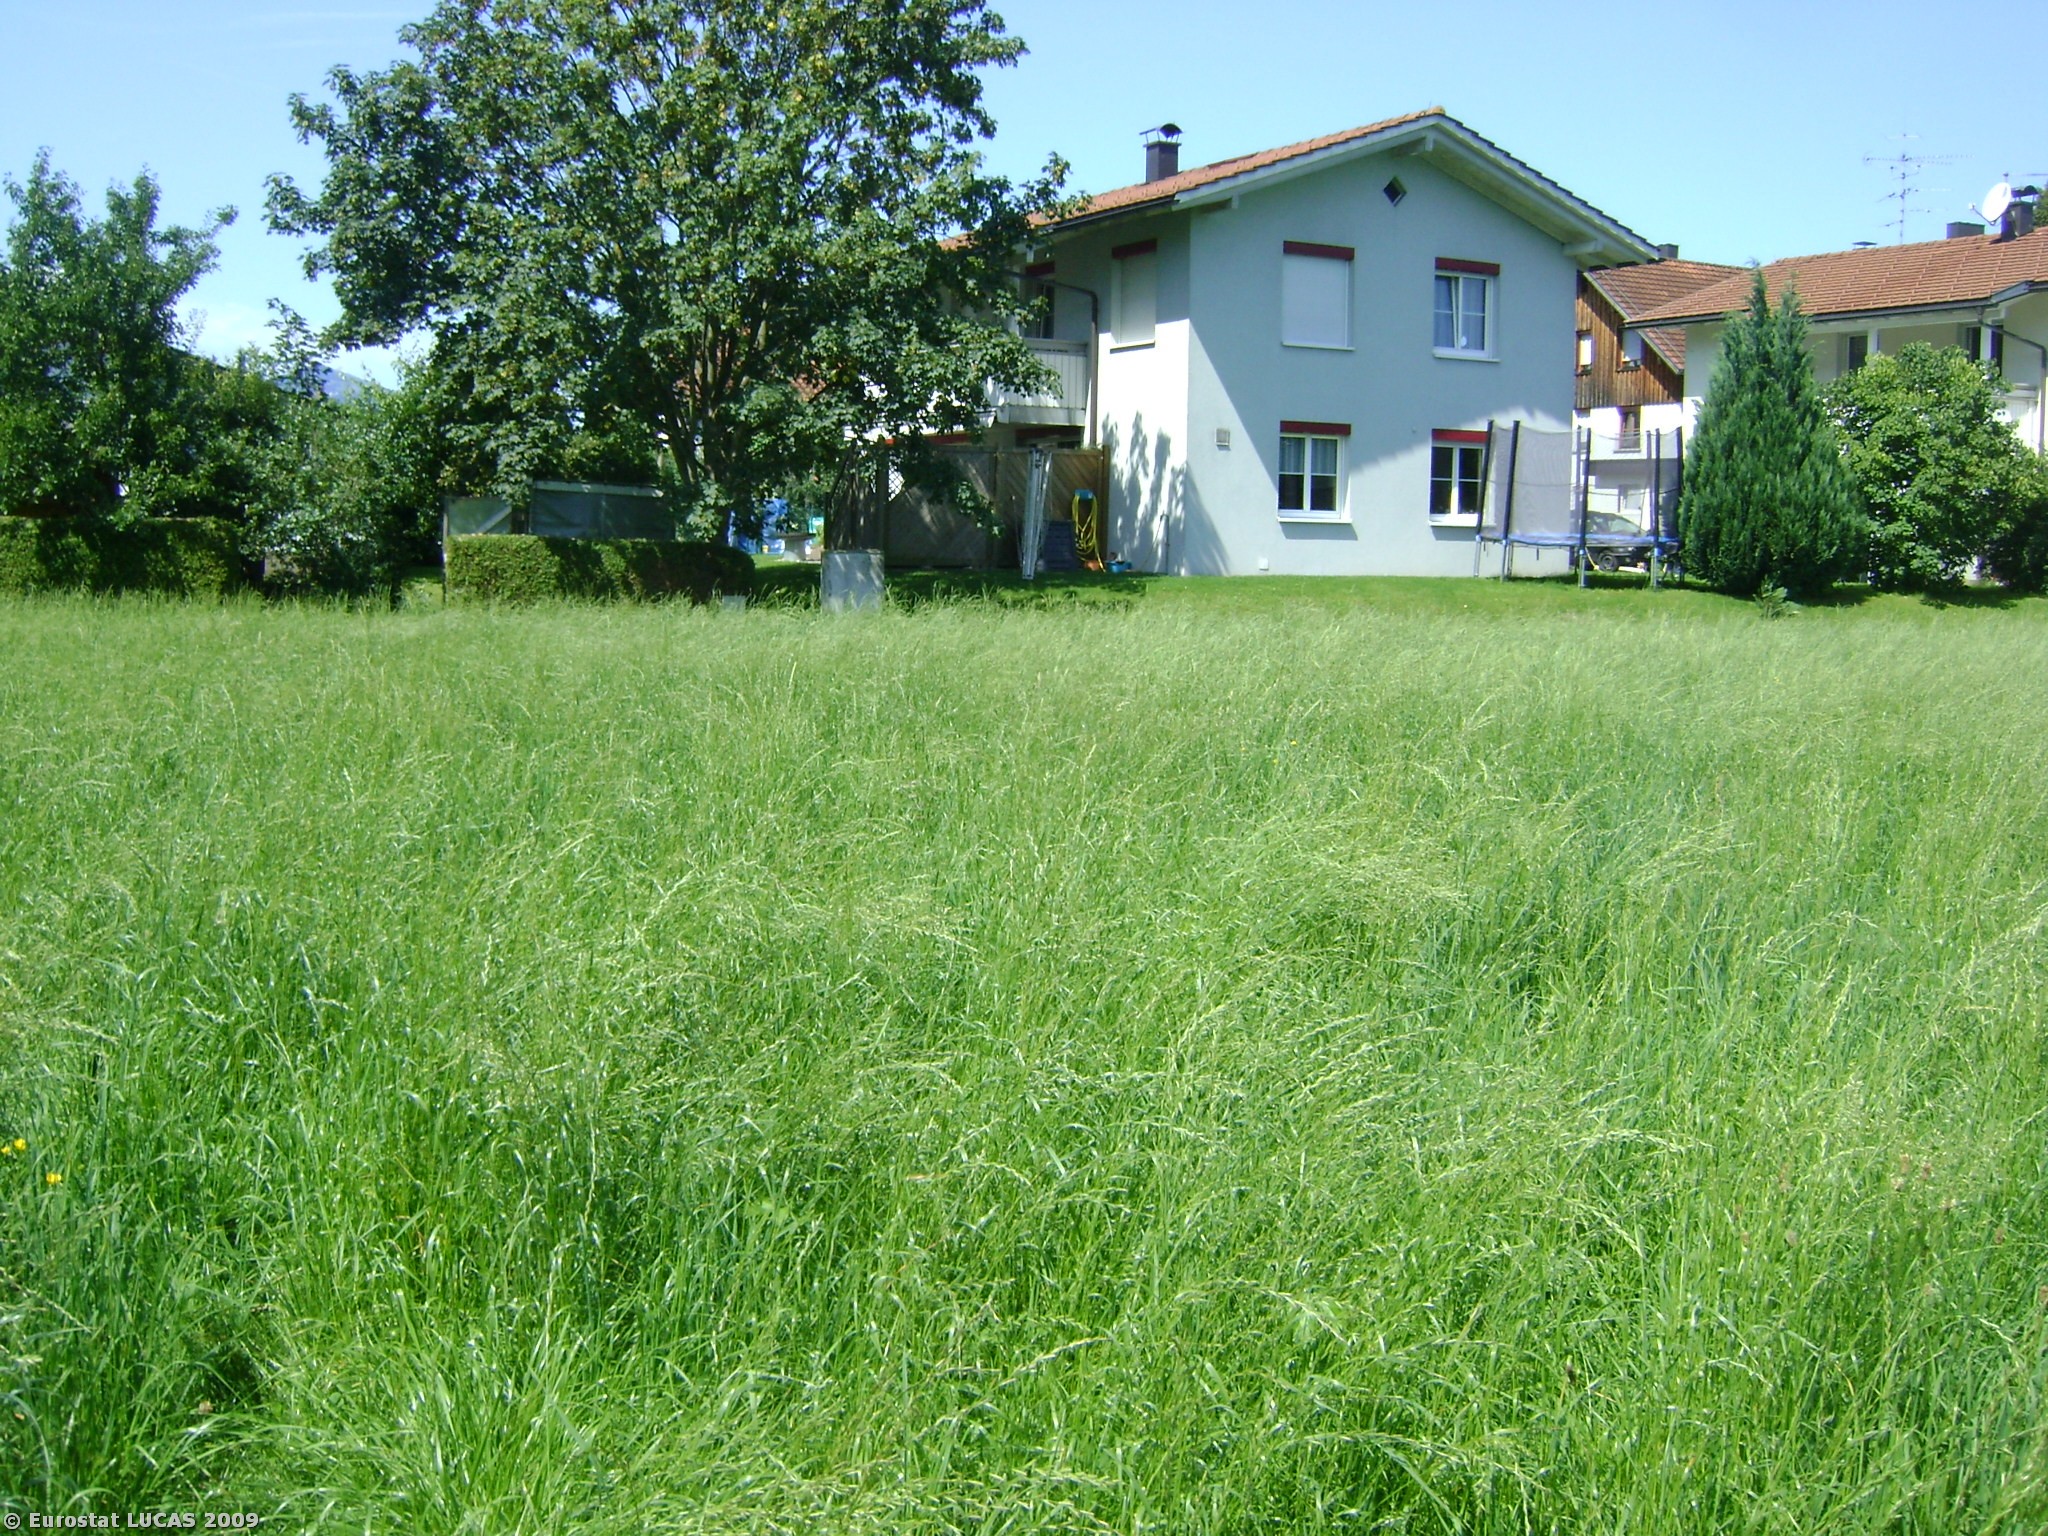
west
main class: Grassland
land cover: Grassland without tree/shrub cover
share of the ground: > 75 %
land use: Agriculture (excluding fallow land and kitchen gardens)
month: July
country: AT
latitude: 47.3591
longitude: 9.6693
